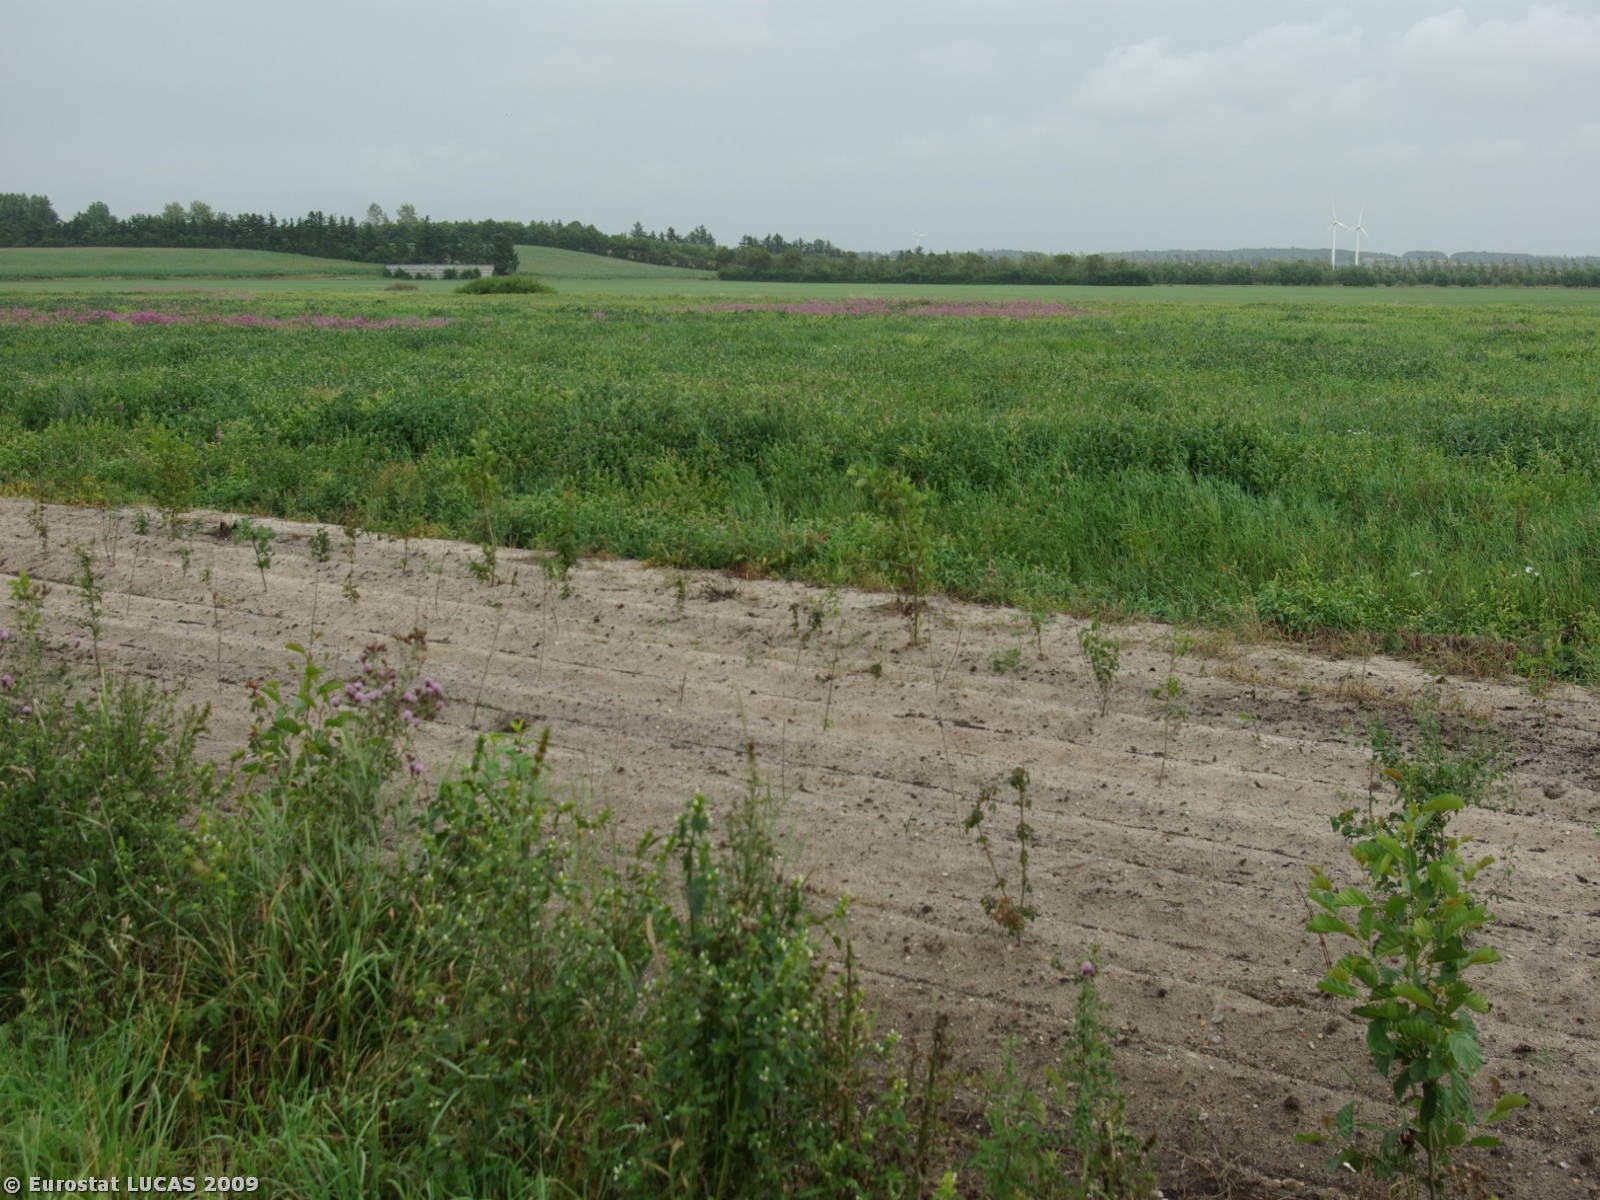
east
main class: Cropland
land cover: Barley
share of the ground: > 75 %
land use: Agriculture (excluding fallow land and kitchen gardens)
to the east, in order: Barley; Shruby margins; Tracks; Shruby margins; Broadleaved woodland; Spontaneously vegetated surfaces; Shruby margins; Ditches and canals; Spontaneously vegetated surfaces; Grassland without tree/shrub cover
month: July
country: DK
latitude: 55.1041
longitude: 8.8567
